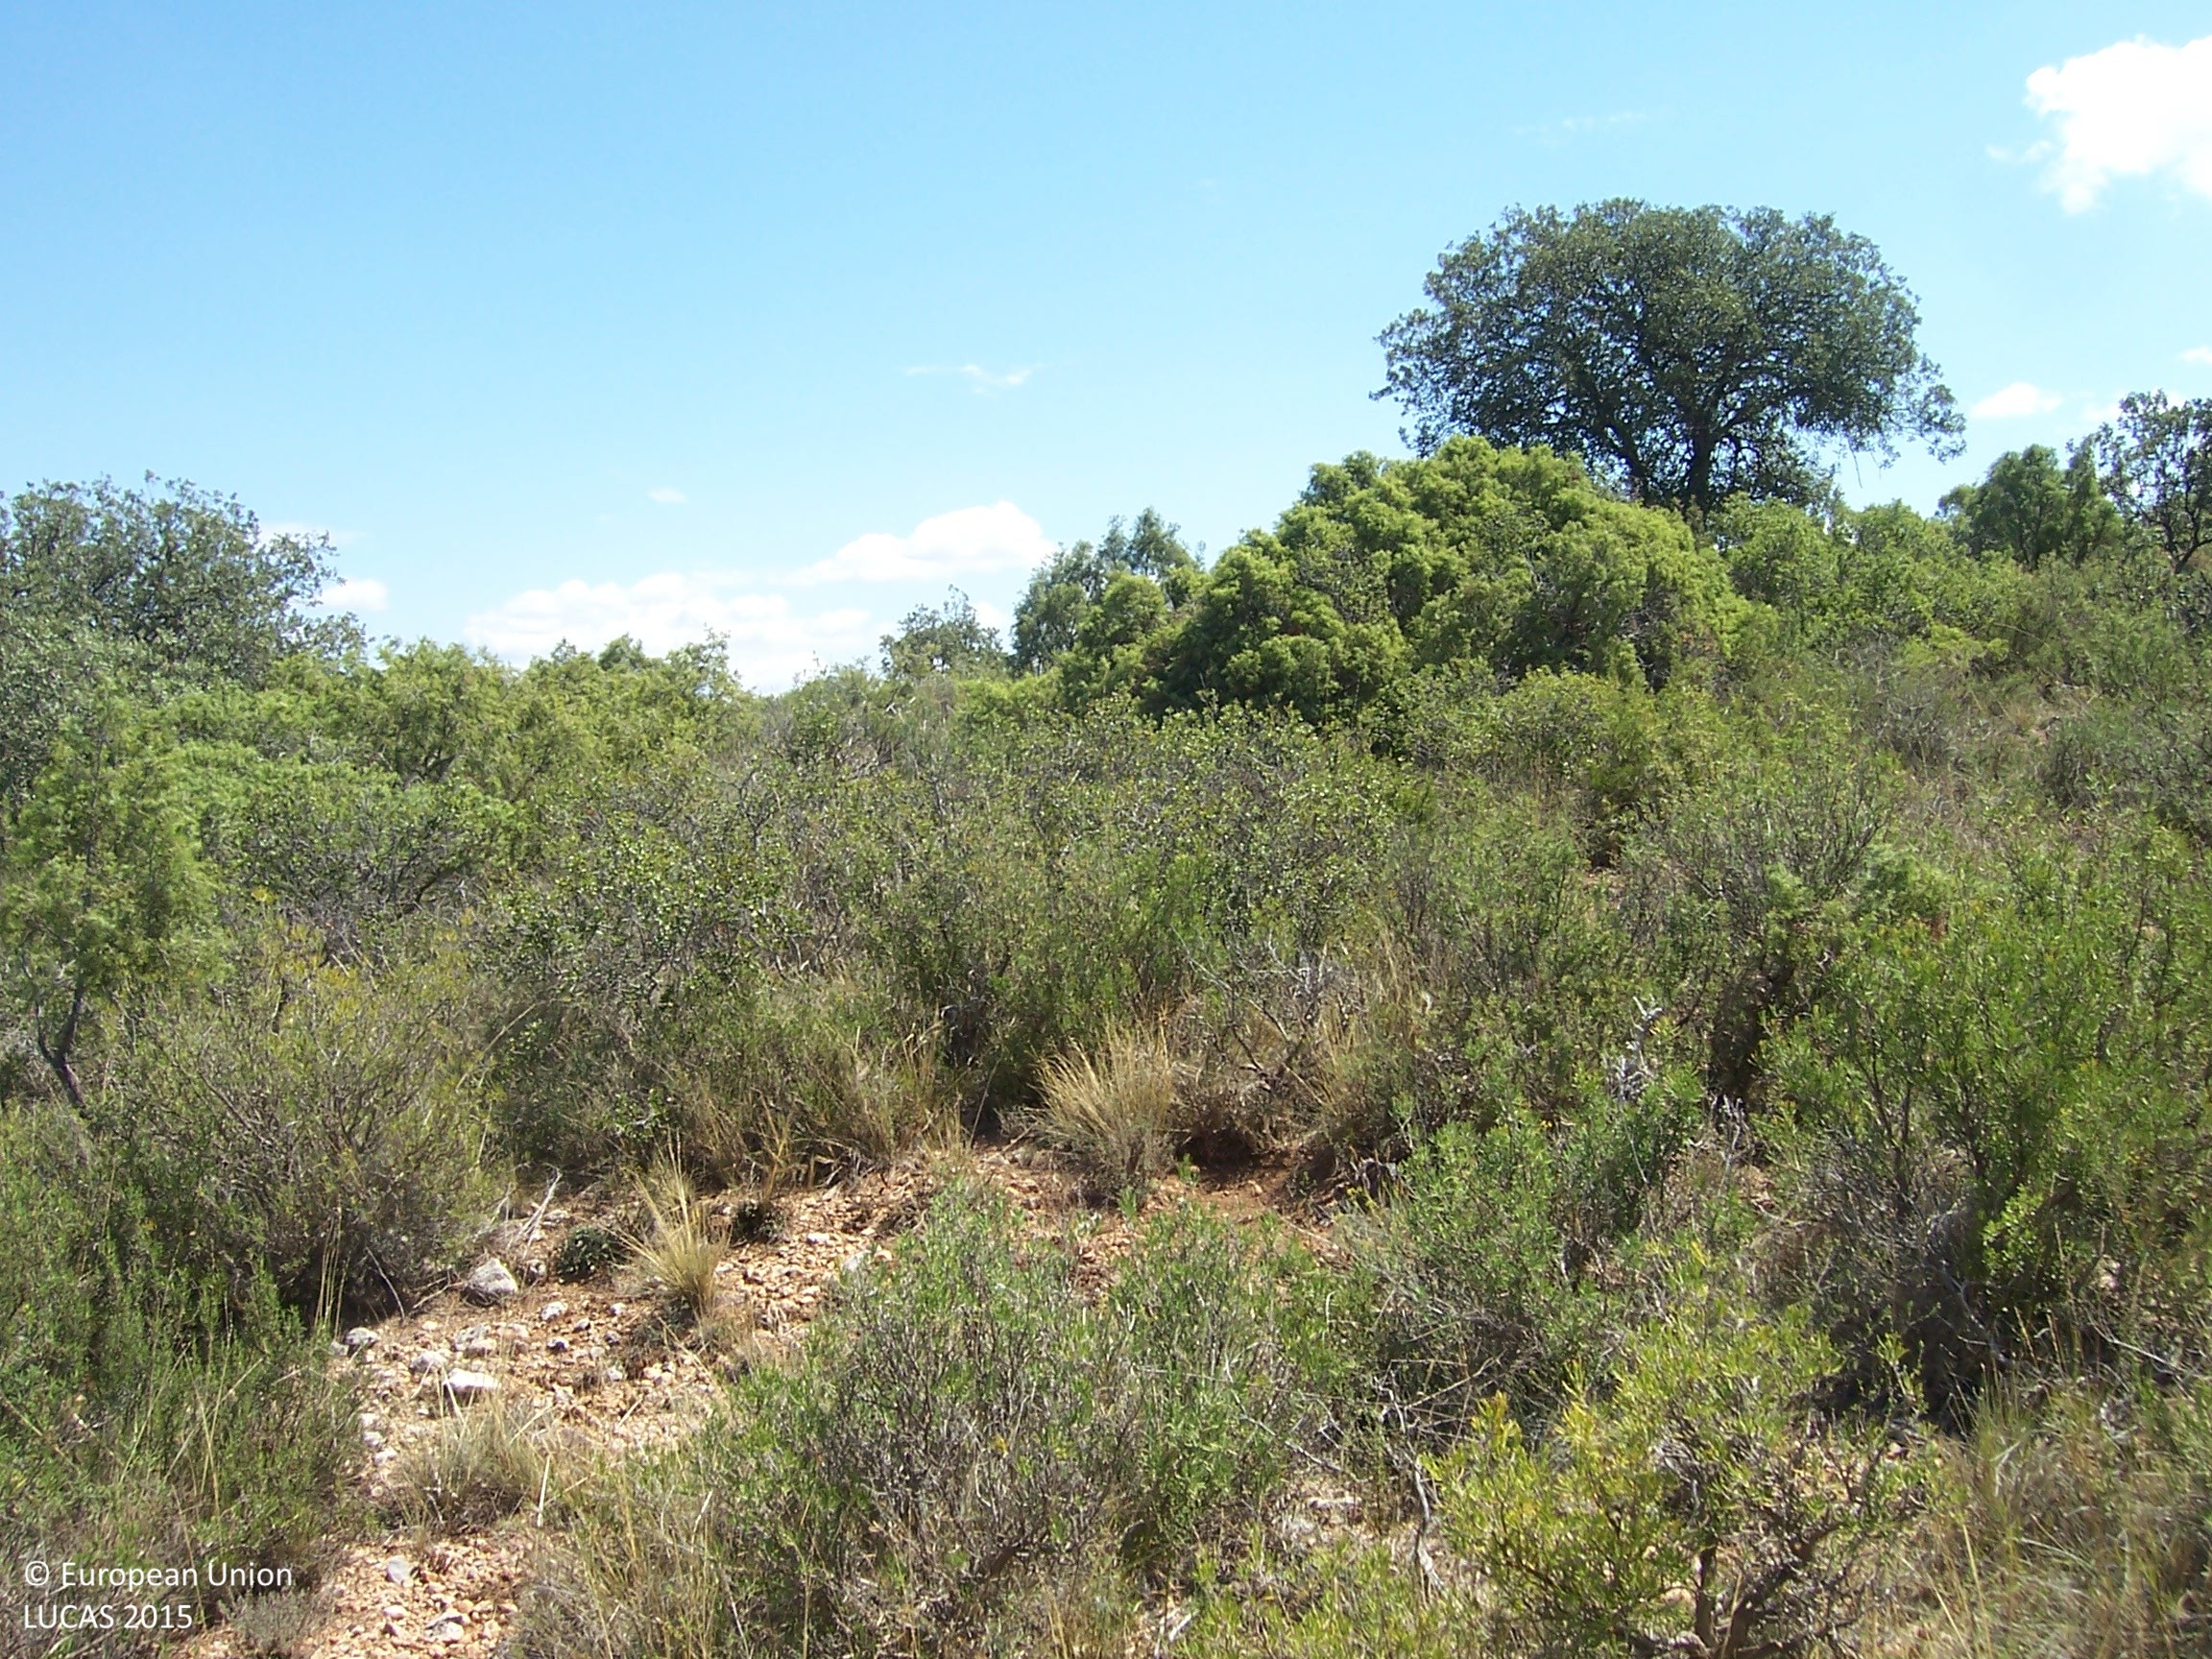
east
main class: Shrubland
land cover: Shrubland with sparse tree cover
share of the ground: > 75 %
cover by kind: shrubs 80 %, herbaceous plants 10 %, broadleaved forest trees 5 %, unconsolidated bare surface 5 %
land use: Semi-natural and natural areas not in use
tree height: < 5 m
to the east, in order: Shrubland with sparse tree cover; Spontaneously vegetated surfaces; Shrubland without tree cover; Nuts trees; Groves; Nuts trees
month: August
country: ES
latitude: 42.0114
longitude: 0.3595
